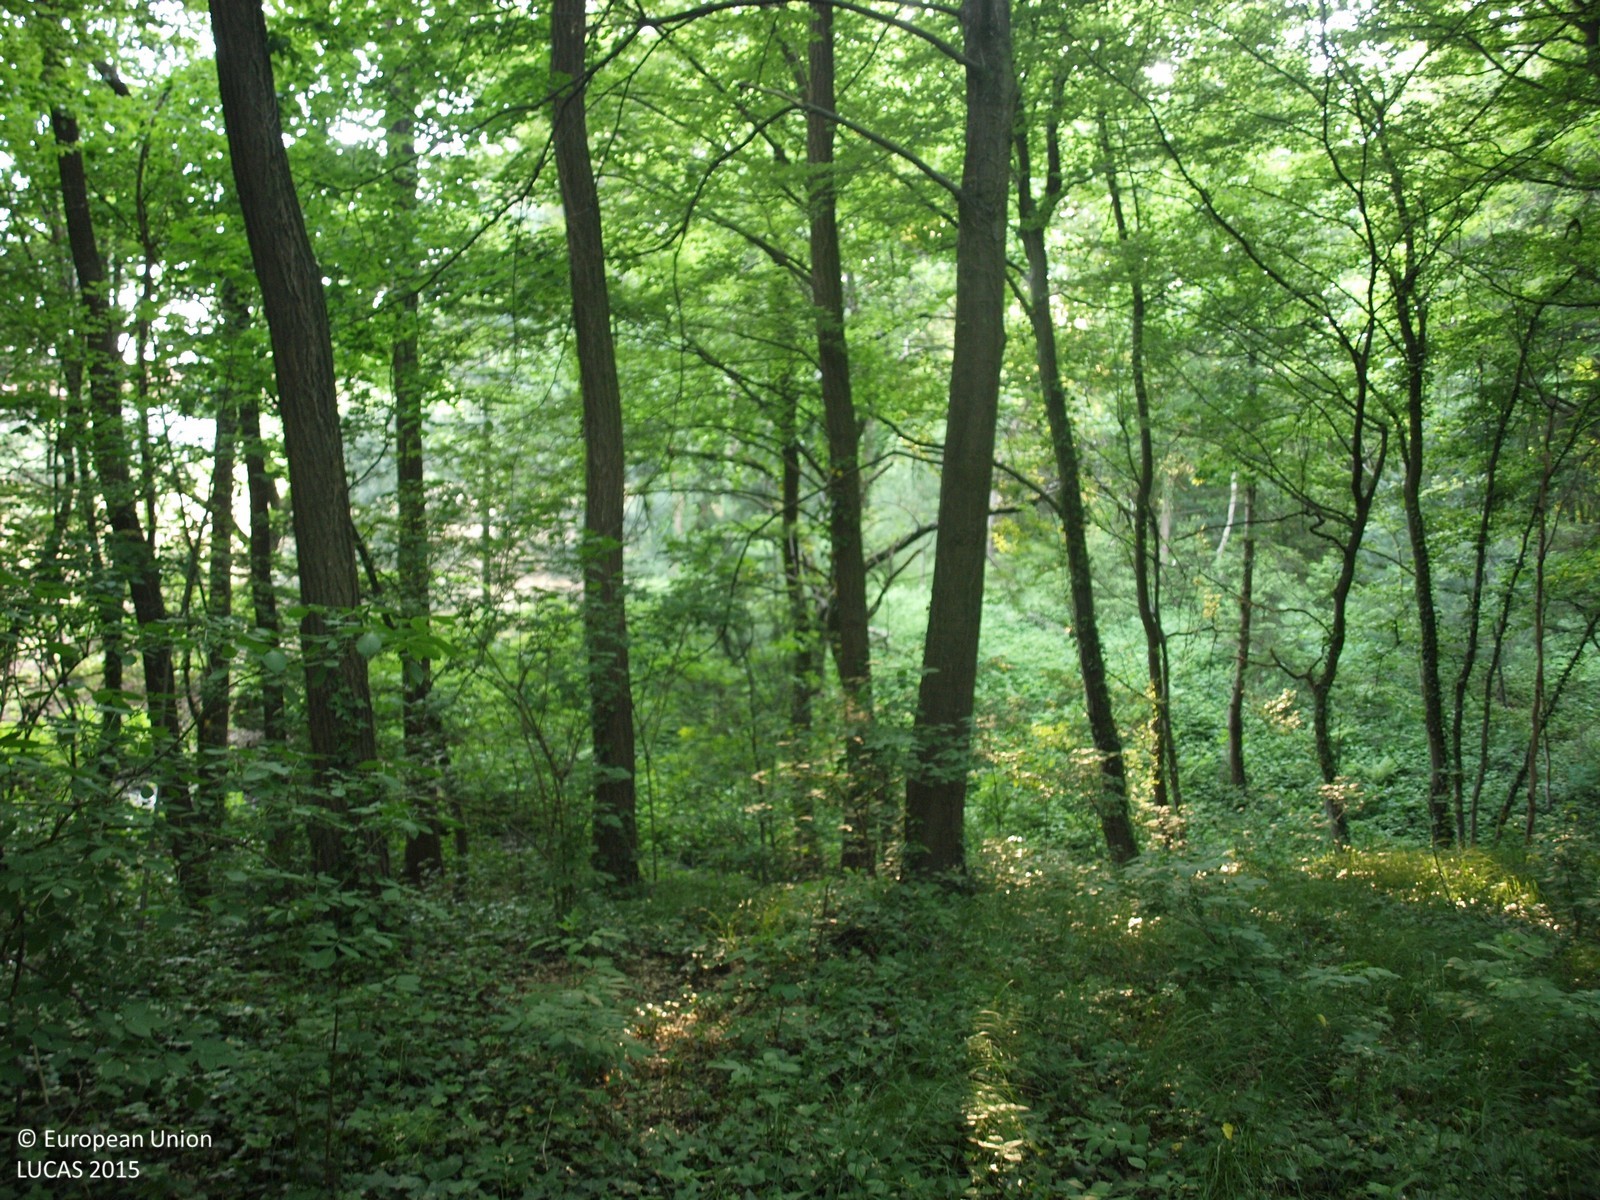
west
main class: Woodland
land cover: Broadleaved woodland
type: mesophytic deciduous forest
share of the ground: > 75 %
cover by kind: broadleaved forest trees 95 %, herbaceous plants 5 %
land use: Forestry
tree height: > 5 m
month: May
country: HR
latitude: 46.2623
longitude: 16.1881
